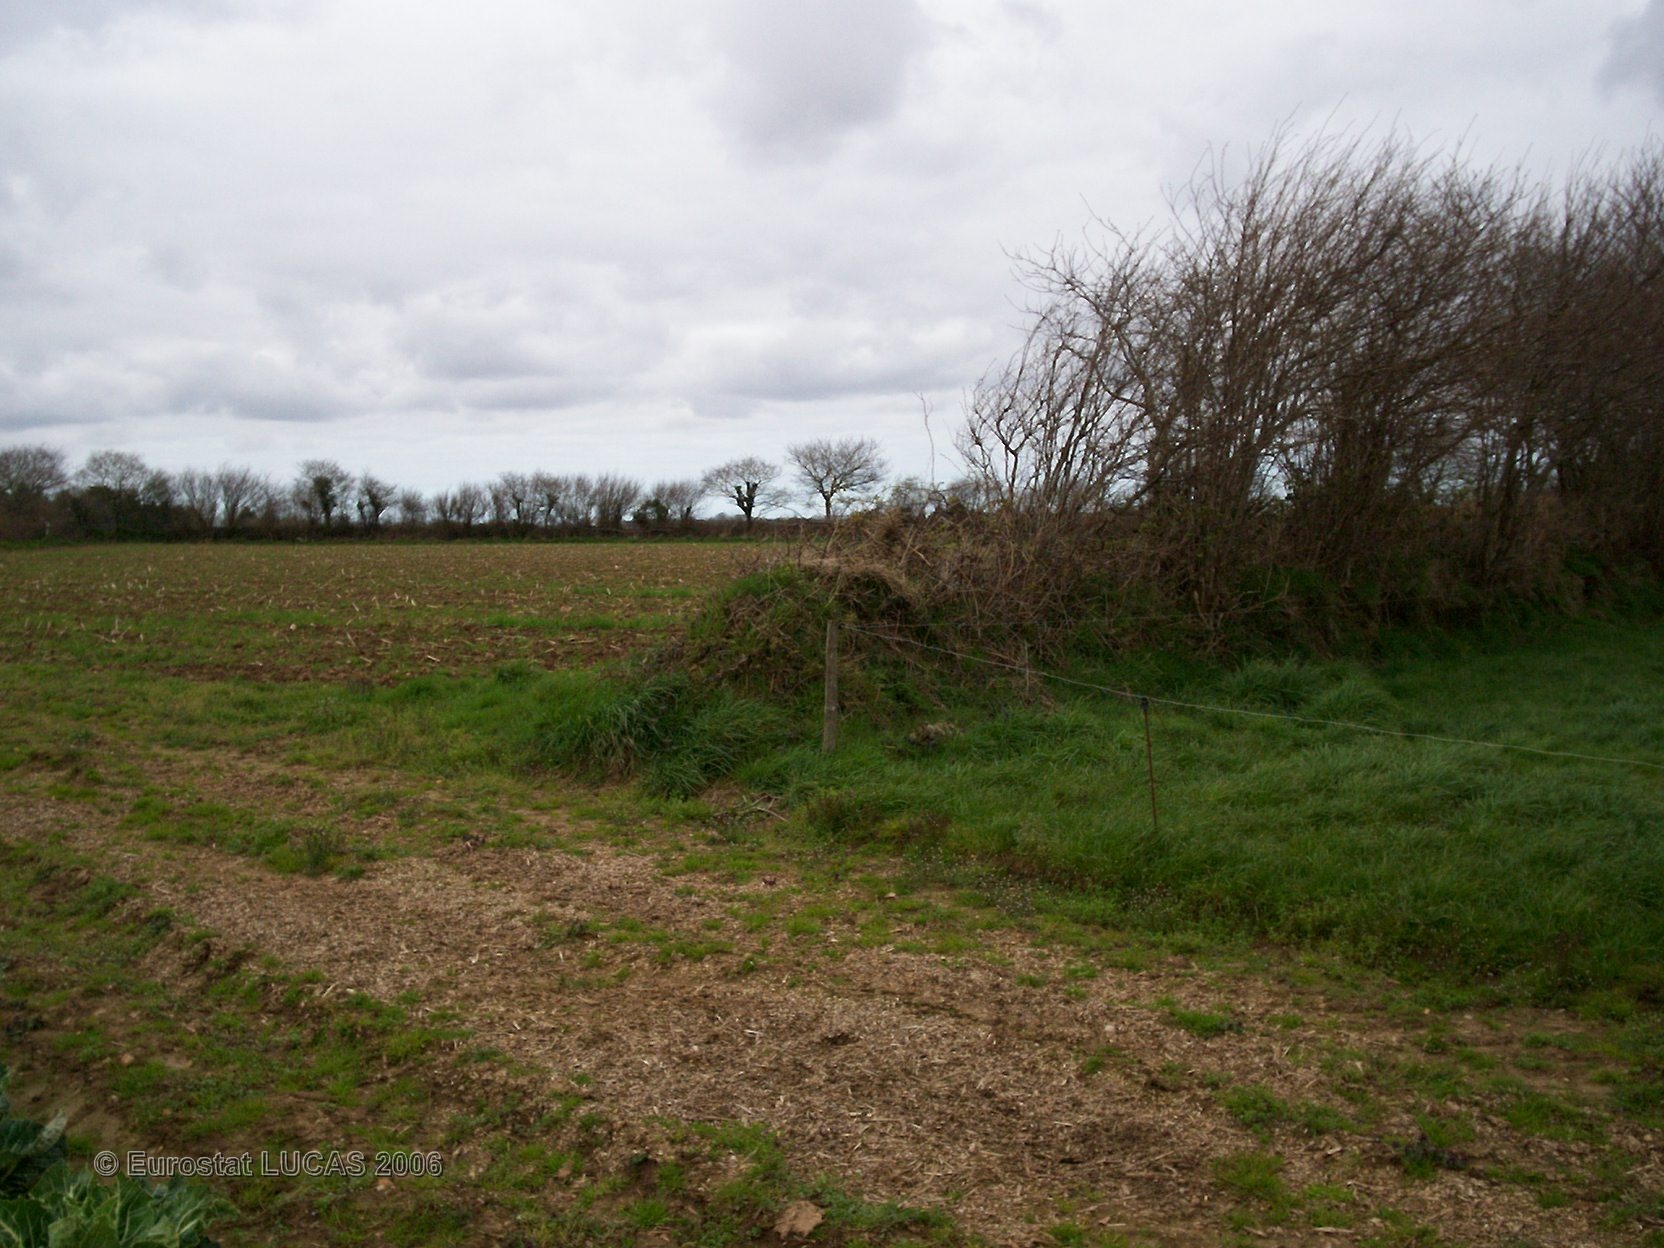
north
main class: Cropland
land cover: Other fresh vegetables
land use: Agriculture (excluding fallow land and kitchen gardens)
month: April
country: FR
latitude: 48.5445
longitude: -4.0278
